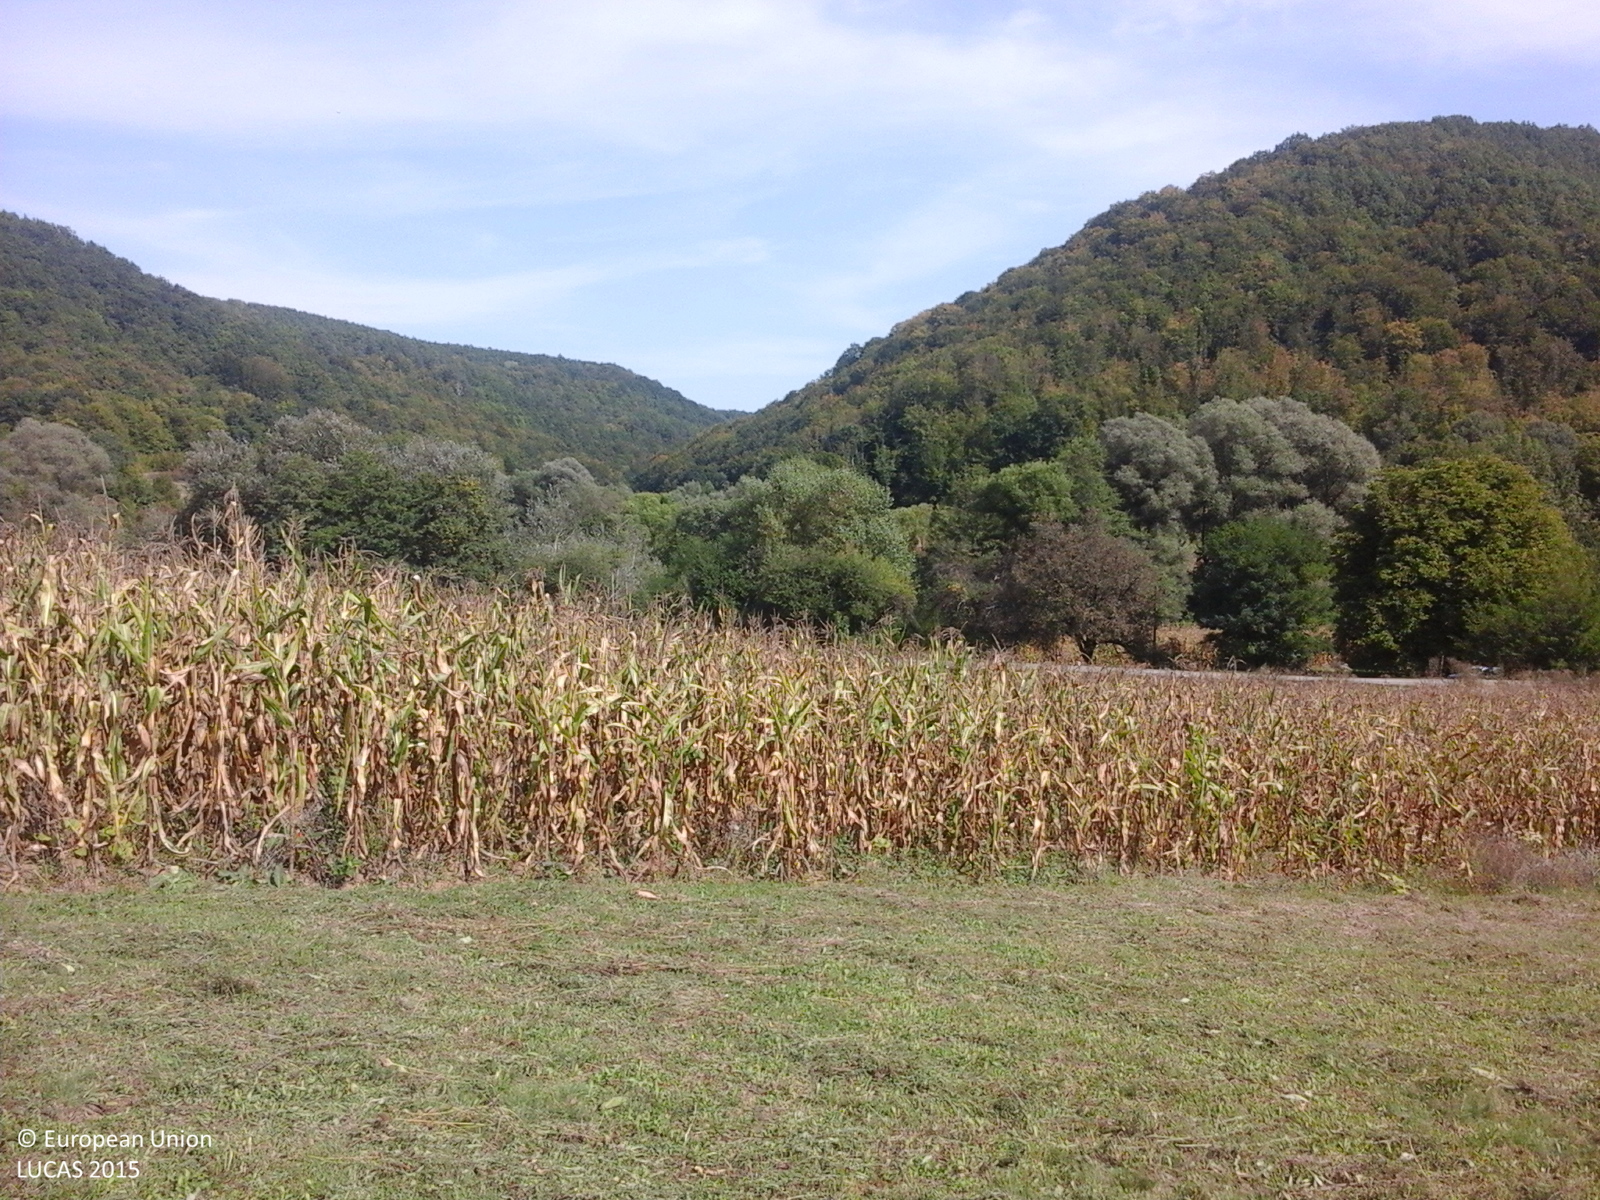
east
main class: Grassland
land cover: Grassland without tree/shrub cover
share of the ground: > 75 %
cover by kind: herbaceous plants 100 %
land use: Agriculture (excluding fallow land and kitchen gardens)
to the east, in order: Grassland without tree/shrub cover; Maize; Spontaneously vegetated surfaces; Grassland without tree/shrub cover; Grass margins; Ditches and canals; Grass margins; Paved roads, cycling and walking lanes; Grass margins; Apple fruit; Electric lines; Apple fruit; Grassland without tree/shrub cover; Broadleaved woodland; Grassland without tree/shrub cover; Lucerne; Maize
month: September
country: RO
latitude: 47.3177
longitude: 23.7704
